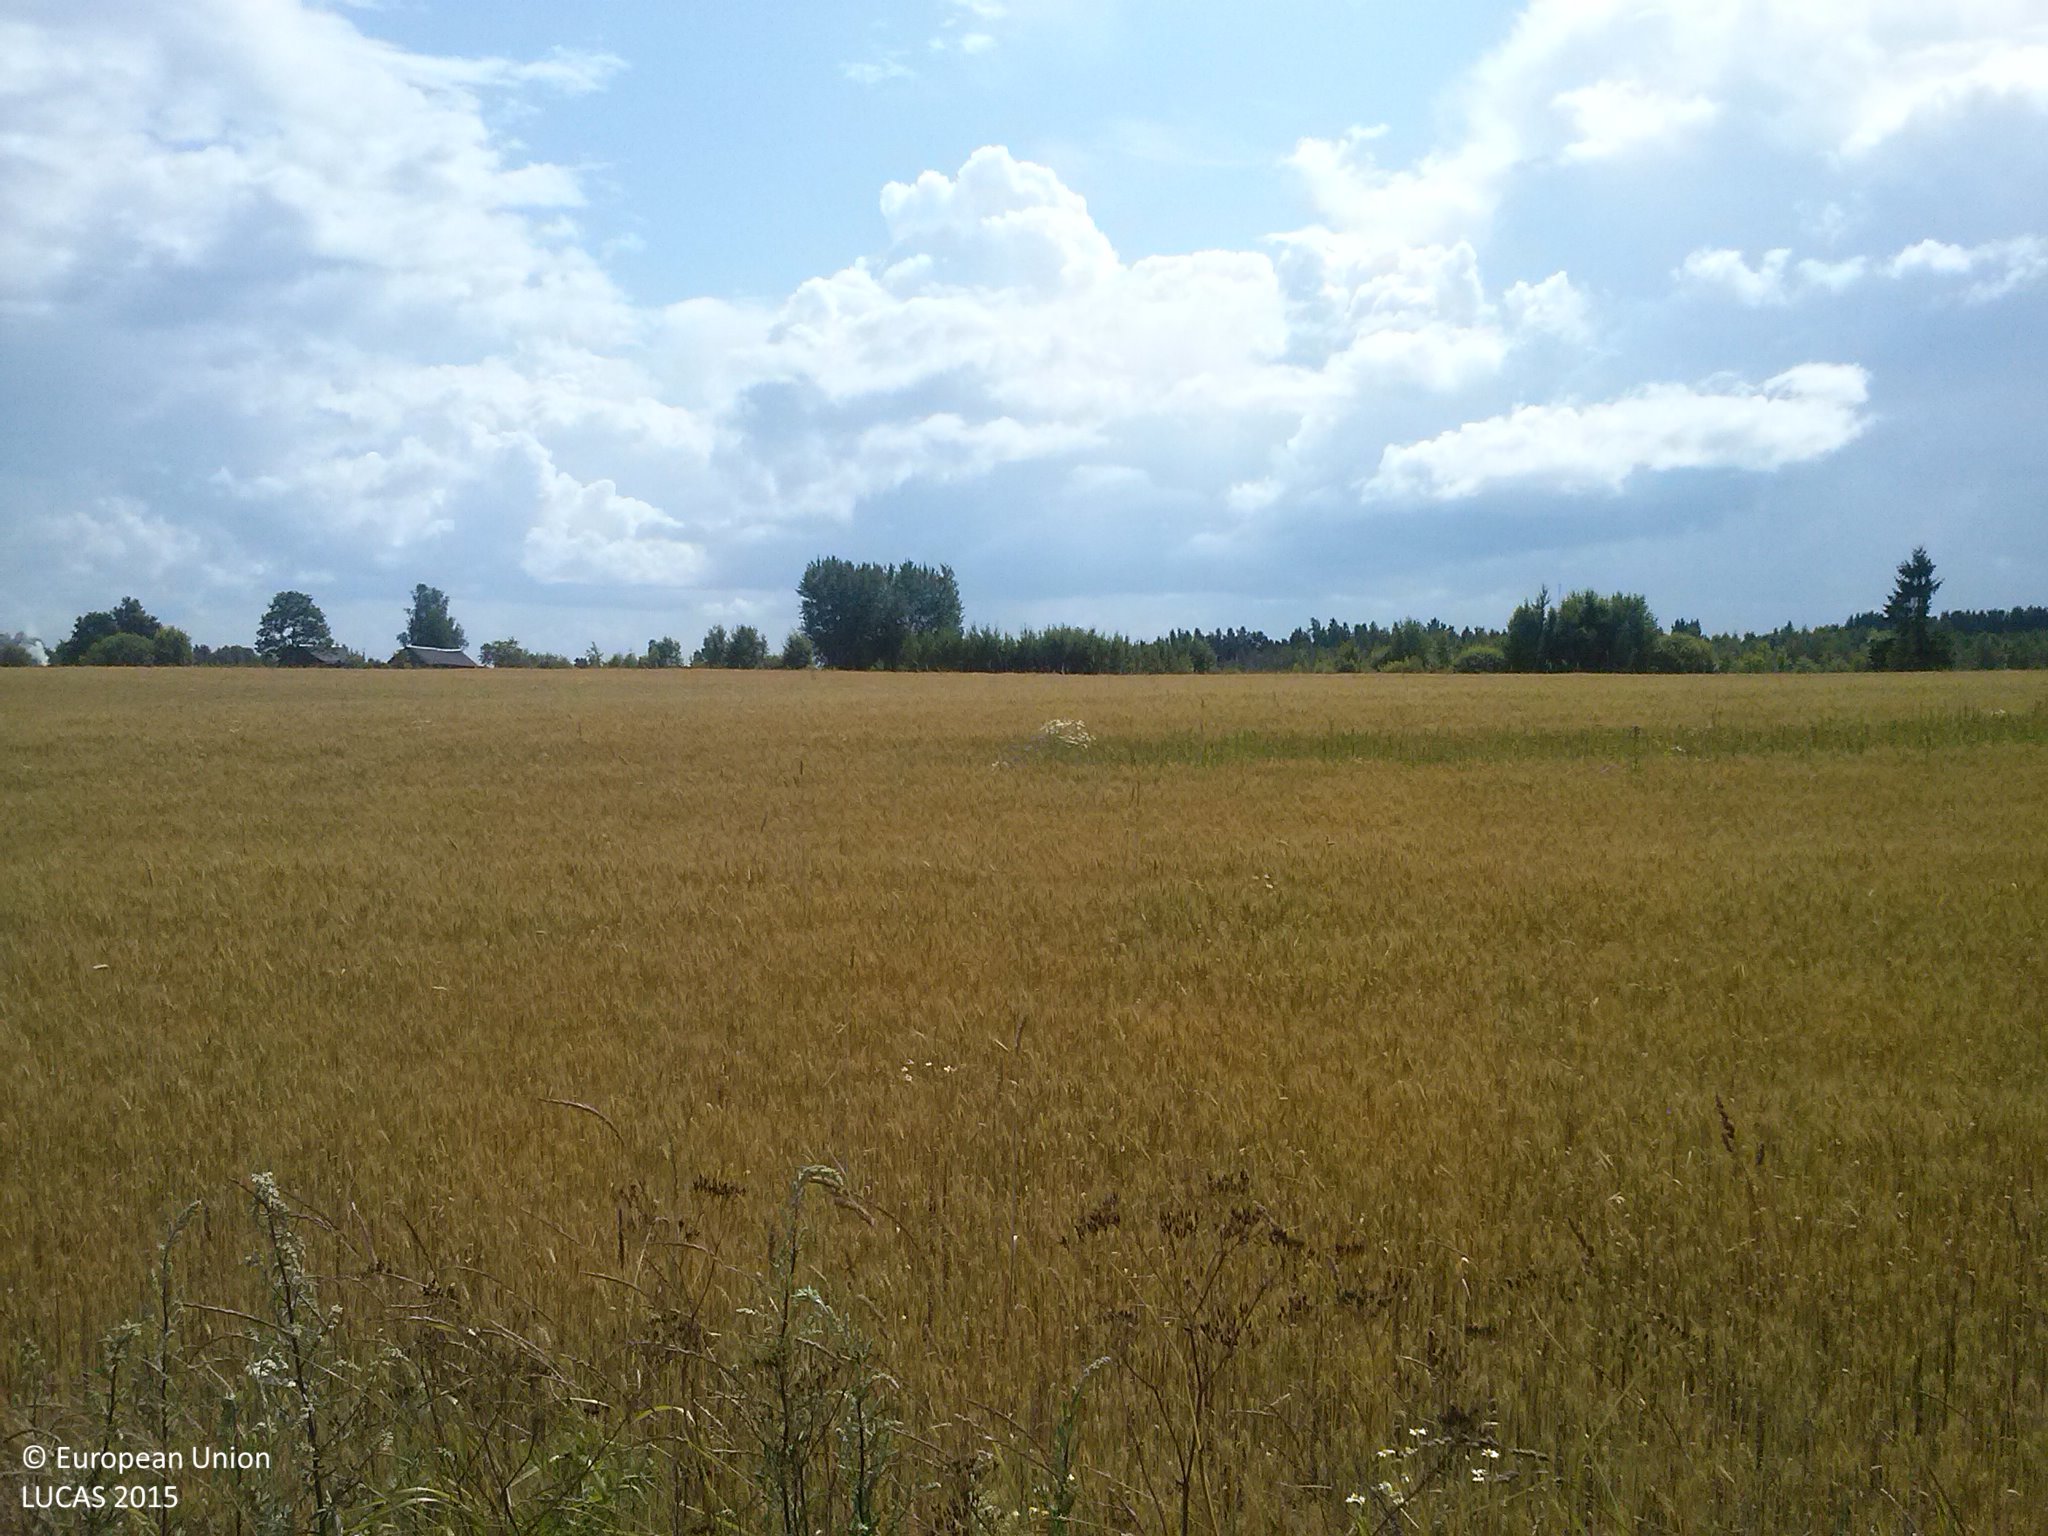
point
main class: Cropland
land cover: Durum wheat
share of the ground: > 75 %
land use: Agriculture (excluding fallow land and kitchen gardens)
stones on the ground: < 10 %
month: July
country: LV
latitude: 56.7176
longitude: 27.5482
